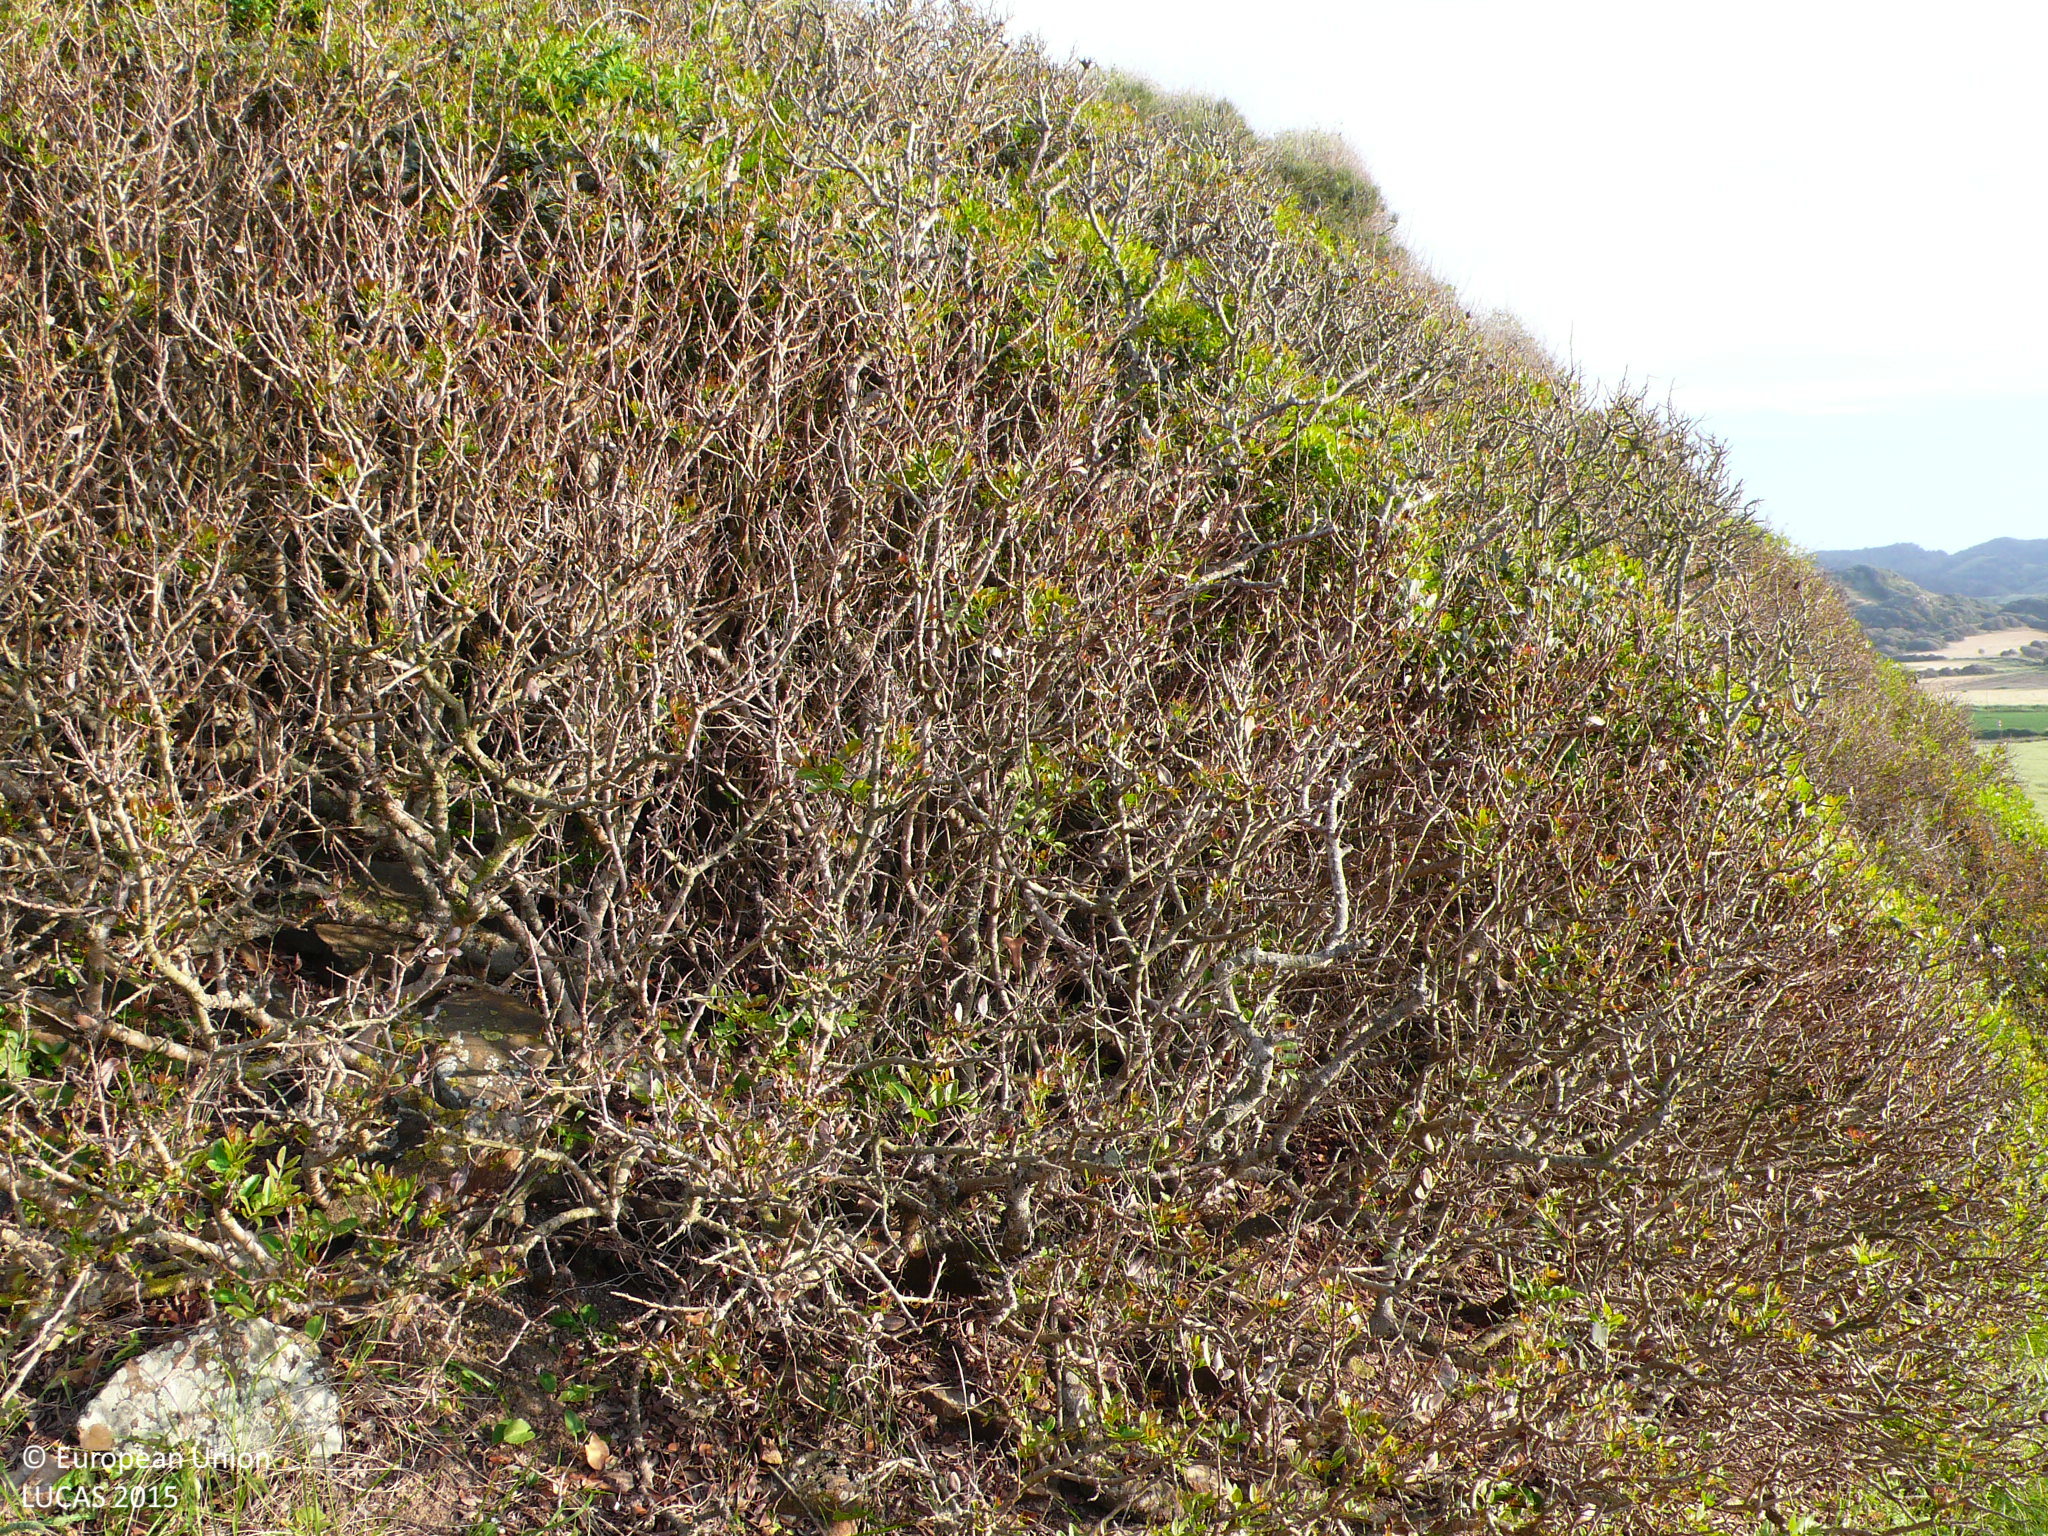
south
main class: Grassland
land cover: Grassland with sparse tree/shrub cover
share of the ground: > 75 %
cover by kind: herbaceous plants 85 %, broadleaved forest trees 5 %, shrubs 5 %, consolidated bare surface 5 %
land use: Agriculture (excluding fallow land and kitchen gardens)
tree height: < 5 m
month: May
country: ES
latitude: 40.0343
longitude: 4.0841
